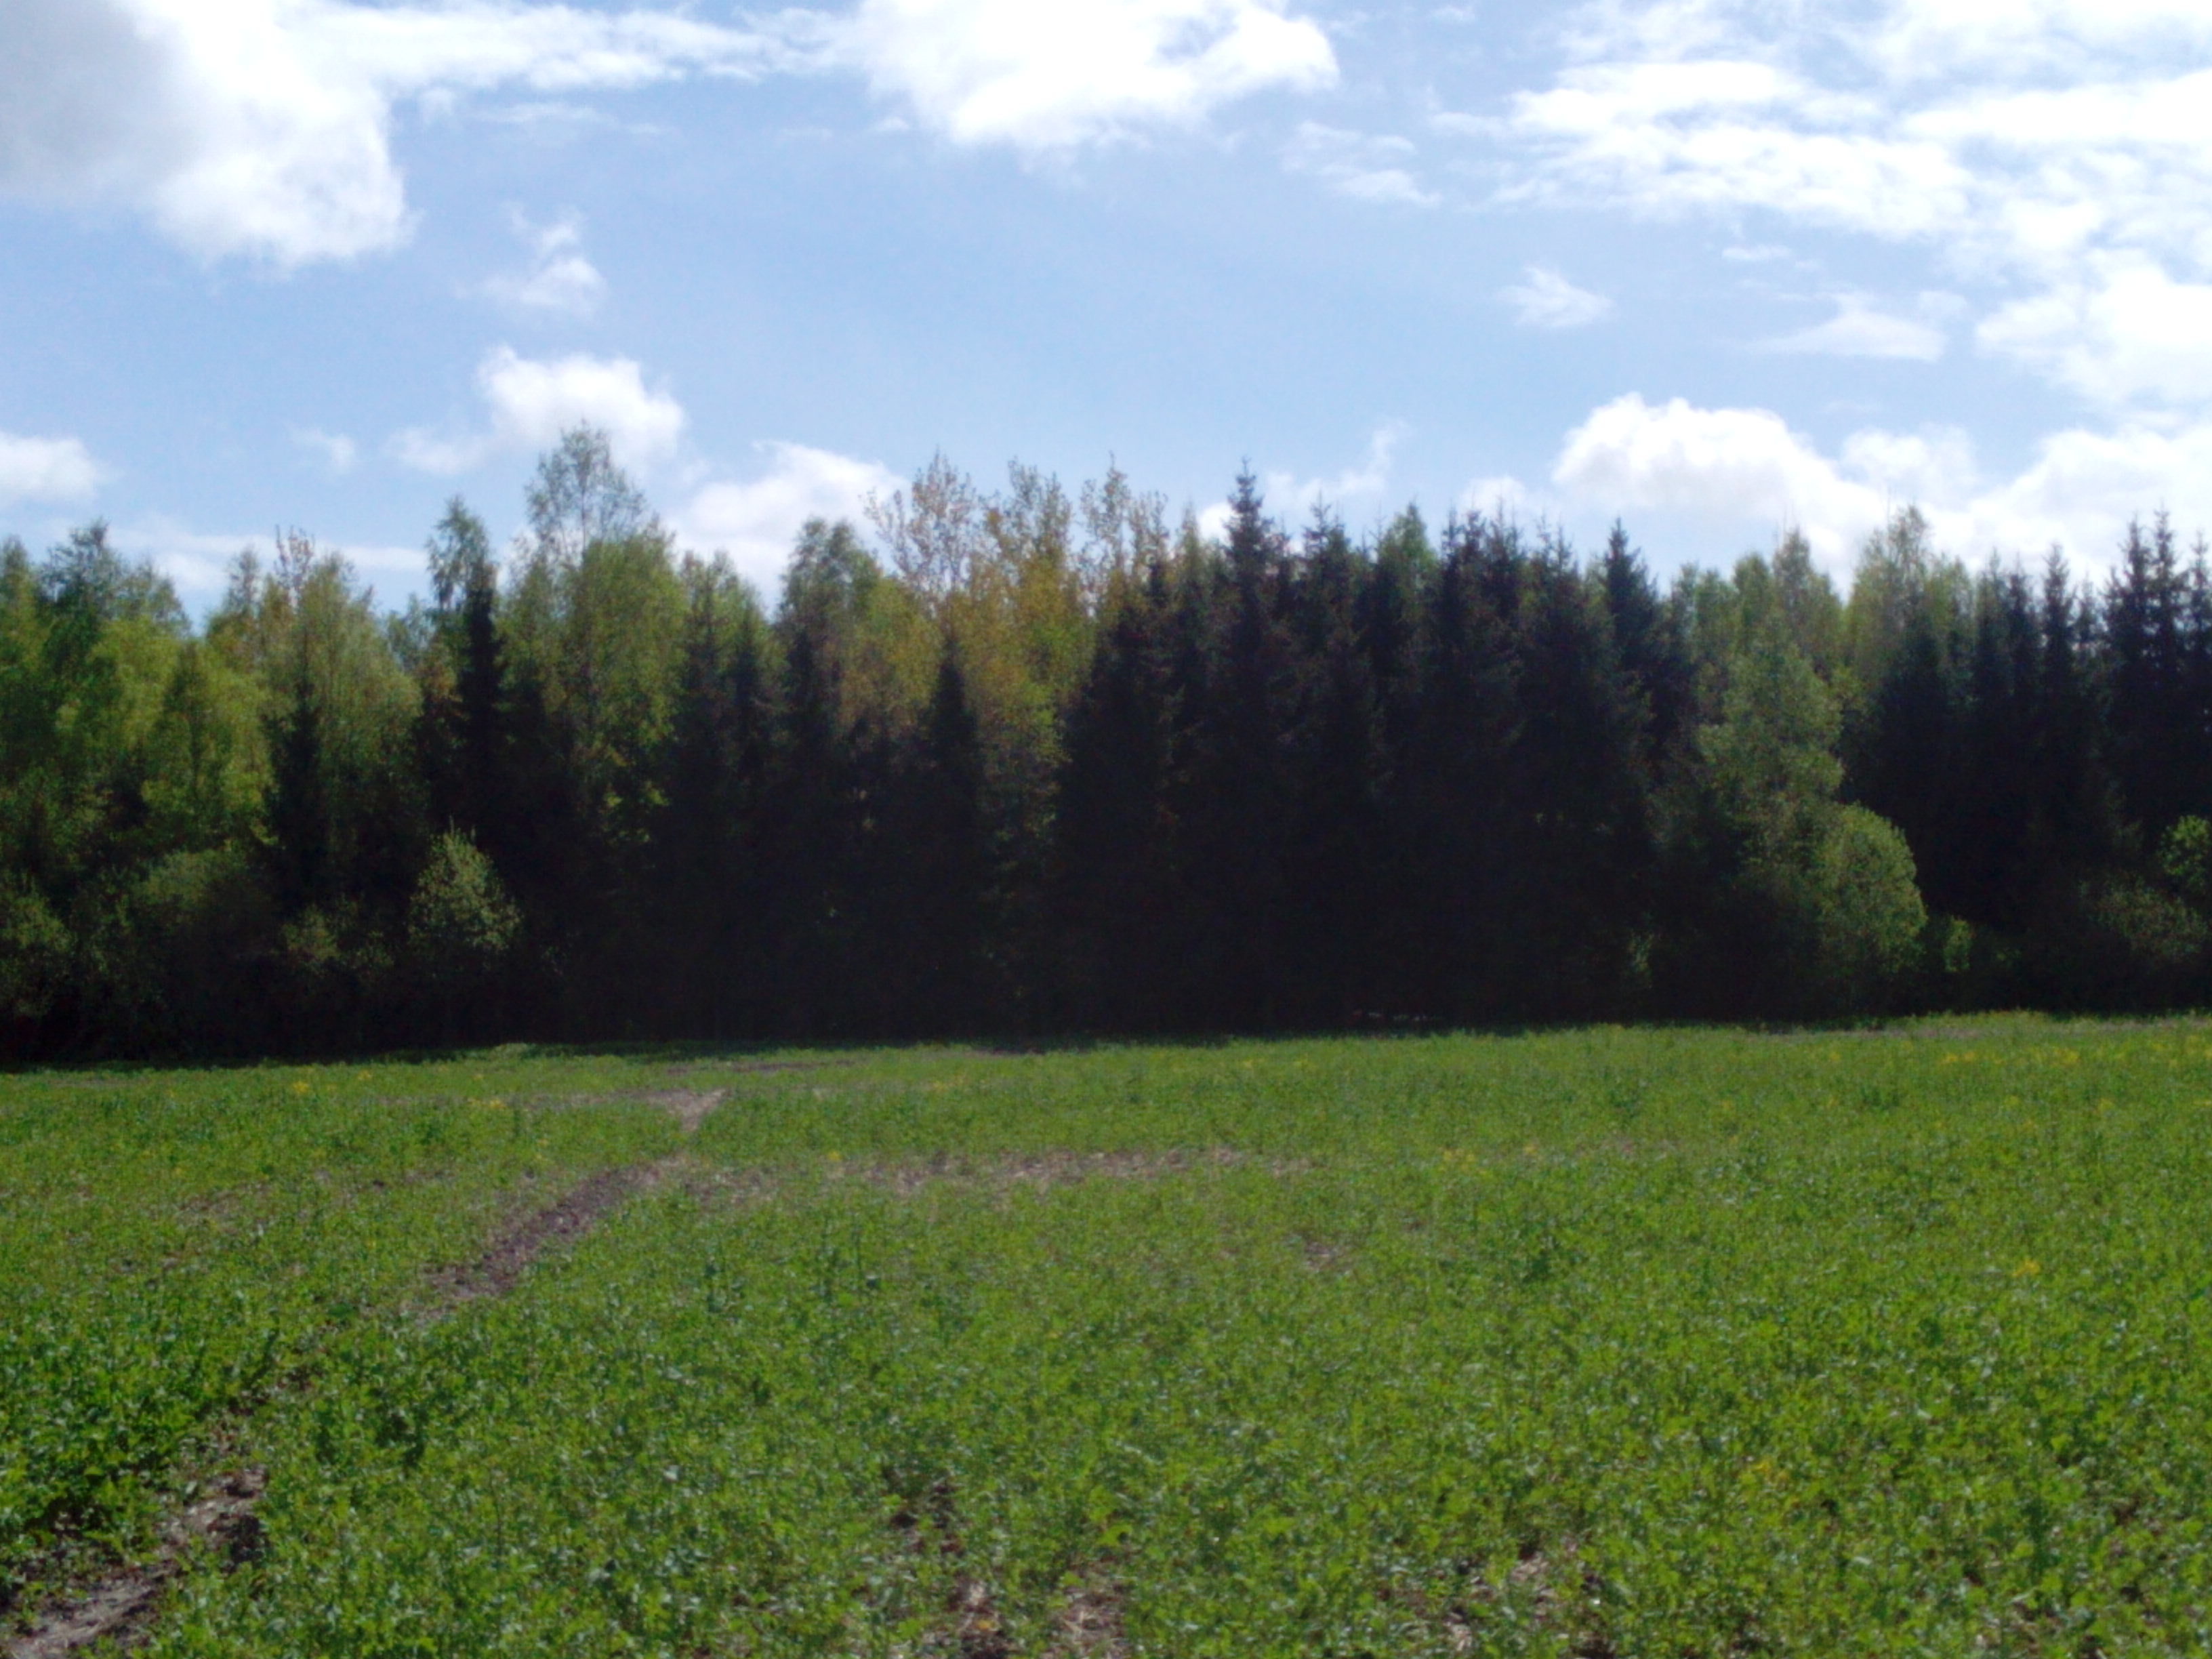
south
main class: Cropland
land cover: Rape and turnip rape
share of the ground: 50 - 75 %
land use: Agriculture (excluding fallow land and kitchen gardens)
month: May
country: LV
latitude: 56.7228
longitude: 22.8576
